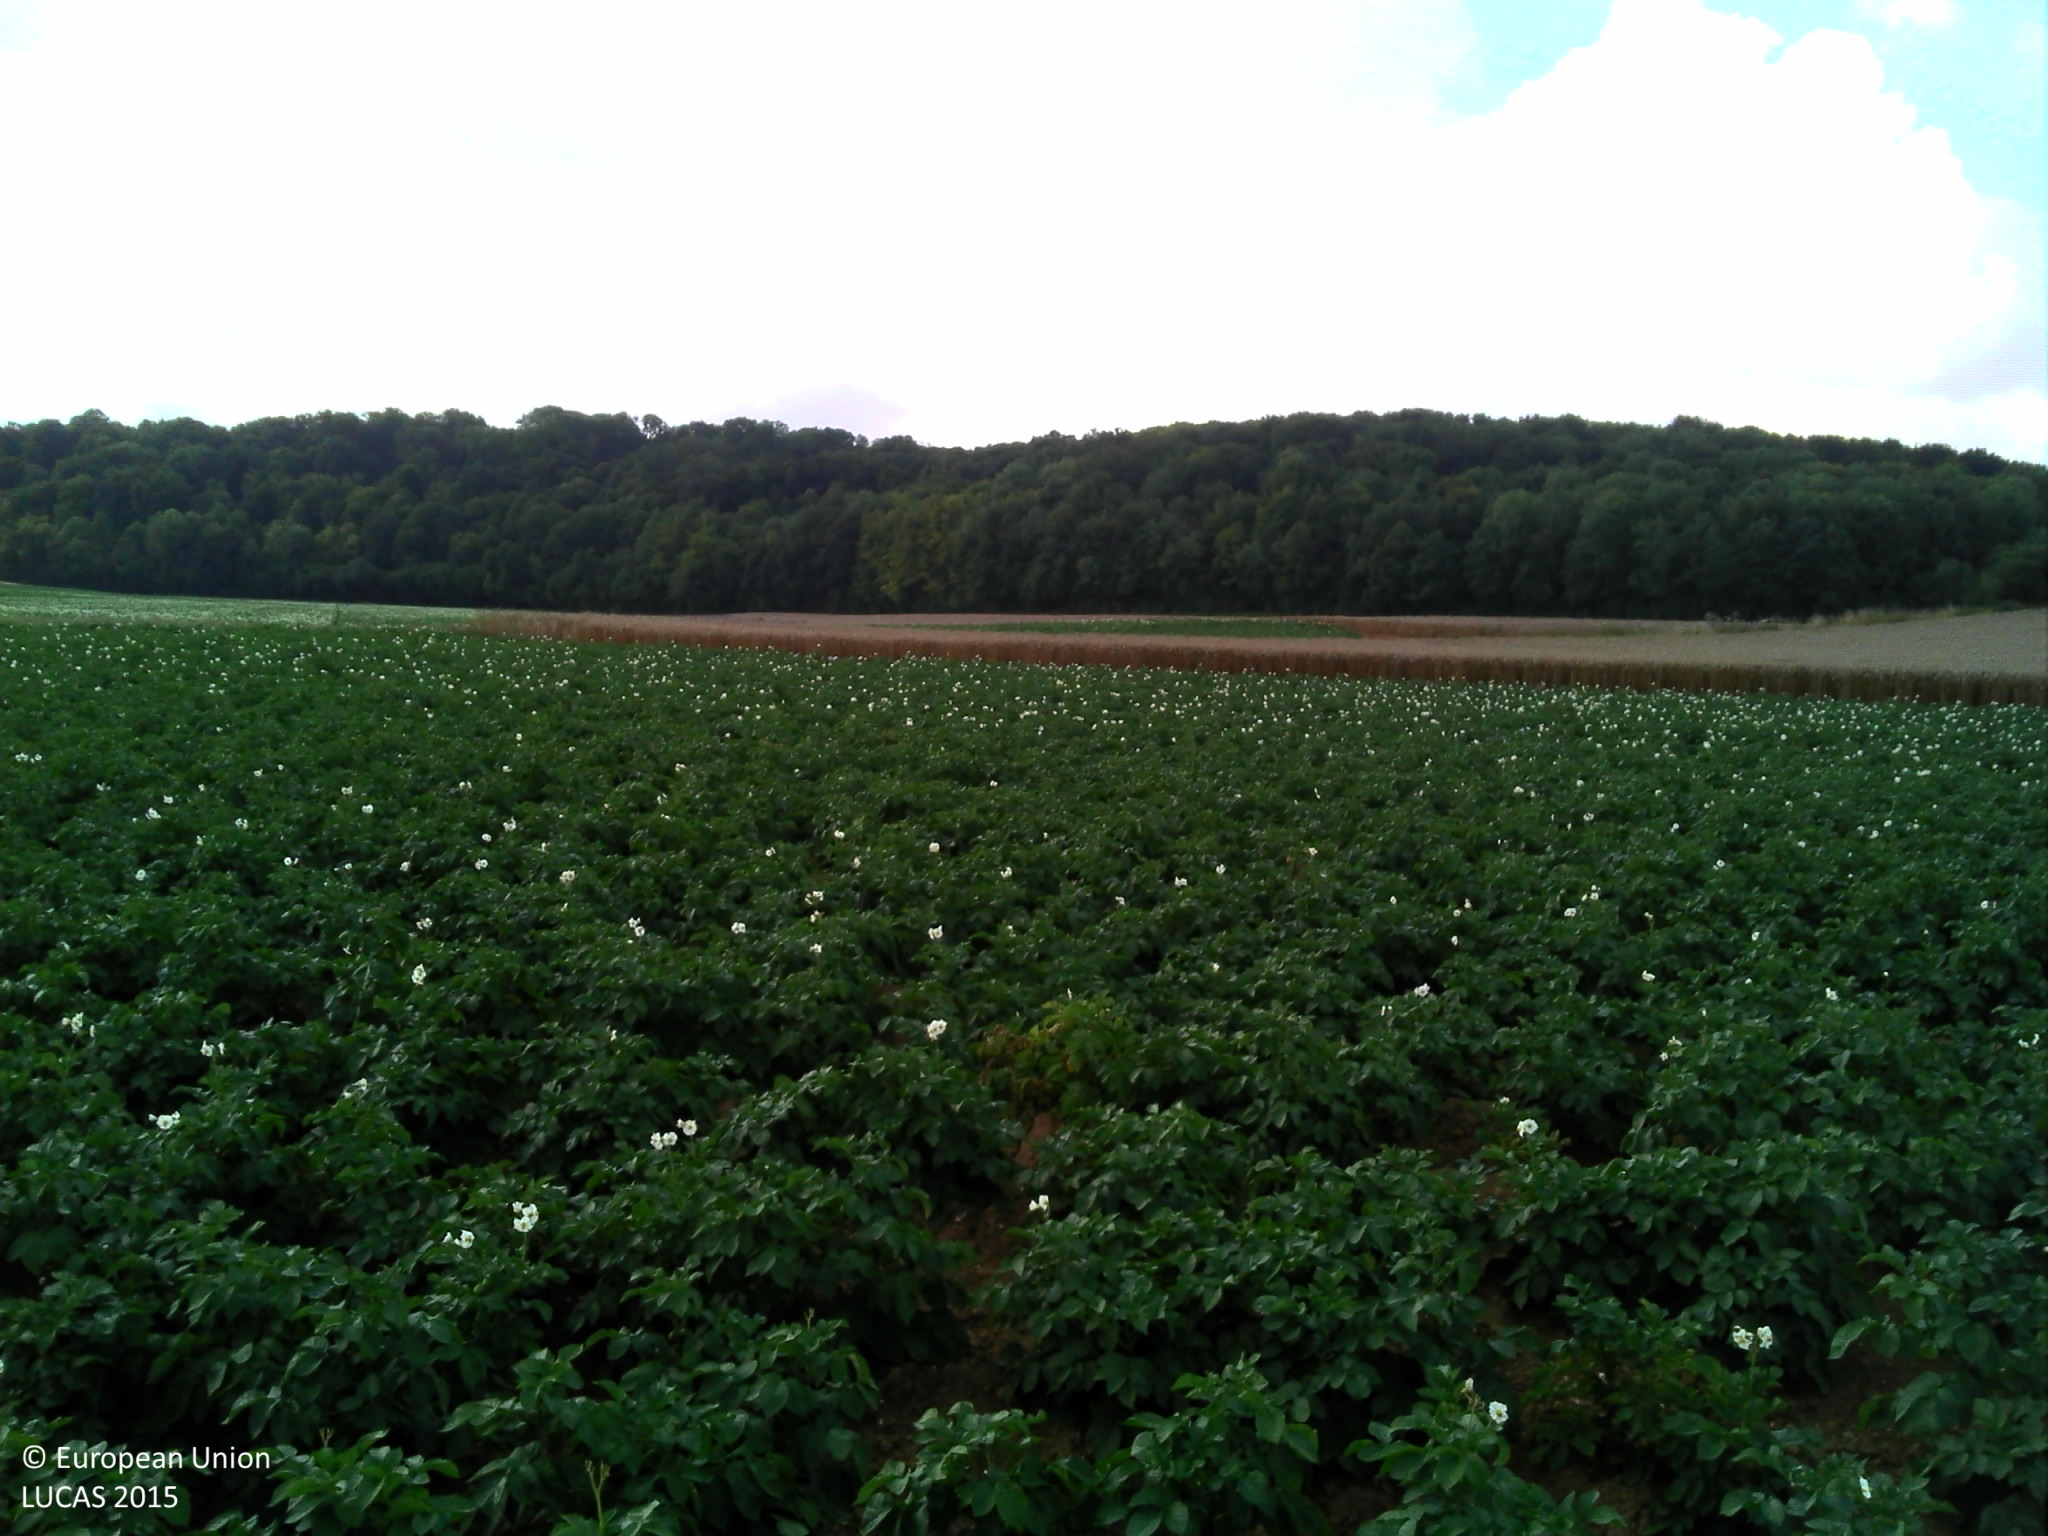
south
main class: Cropland
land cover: Potatoes
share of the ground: > 75 %
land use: Agriculture (excluding fallow land and kitchen gardens)
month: July
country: FR
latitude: 50.0410
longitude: 2.4332
